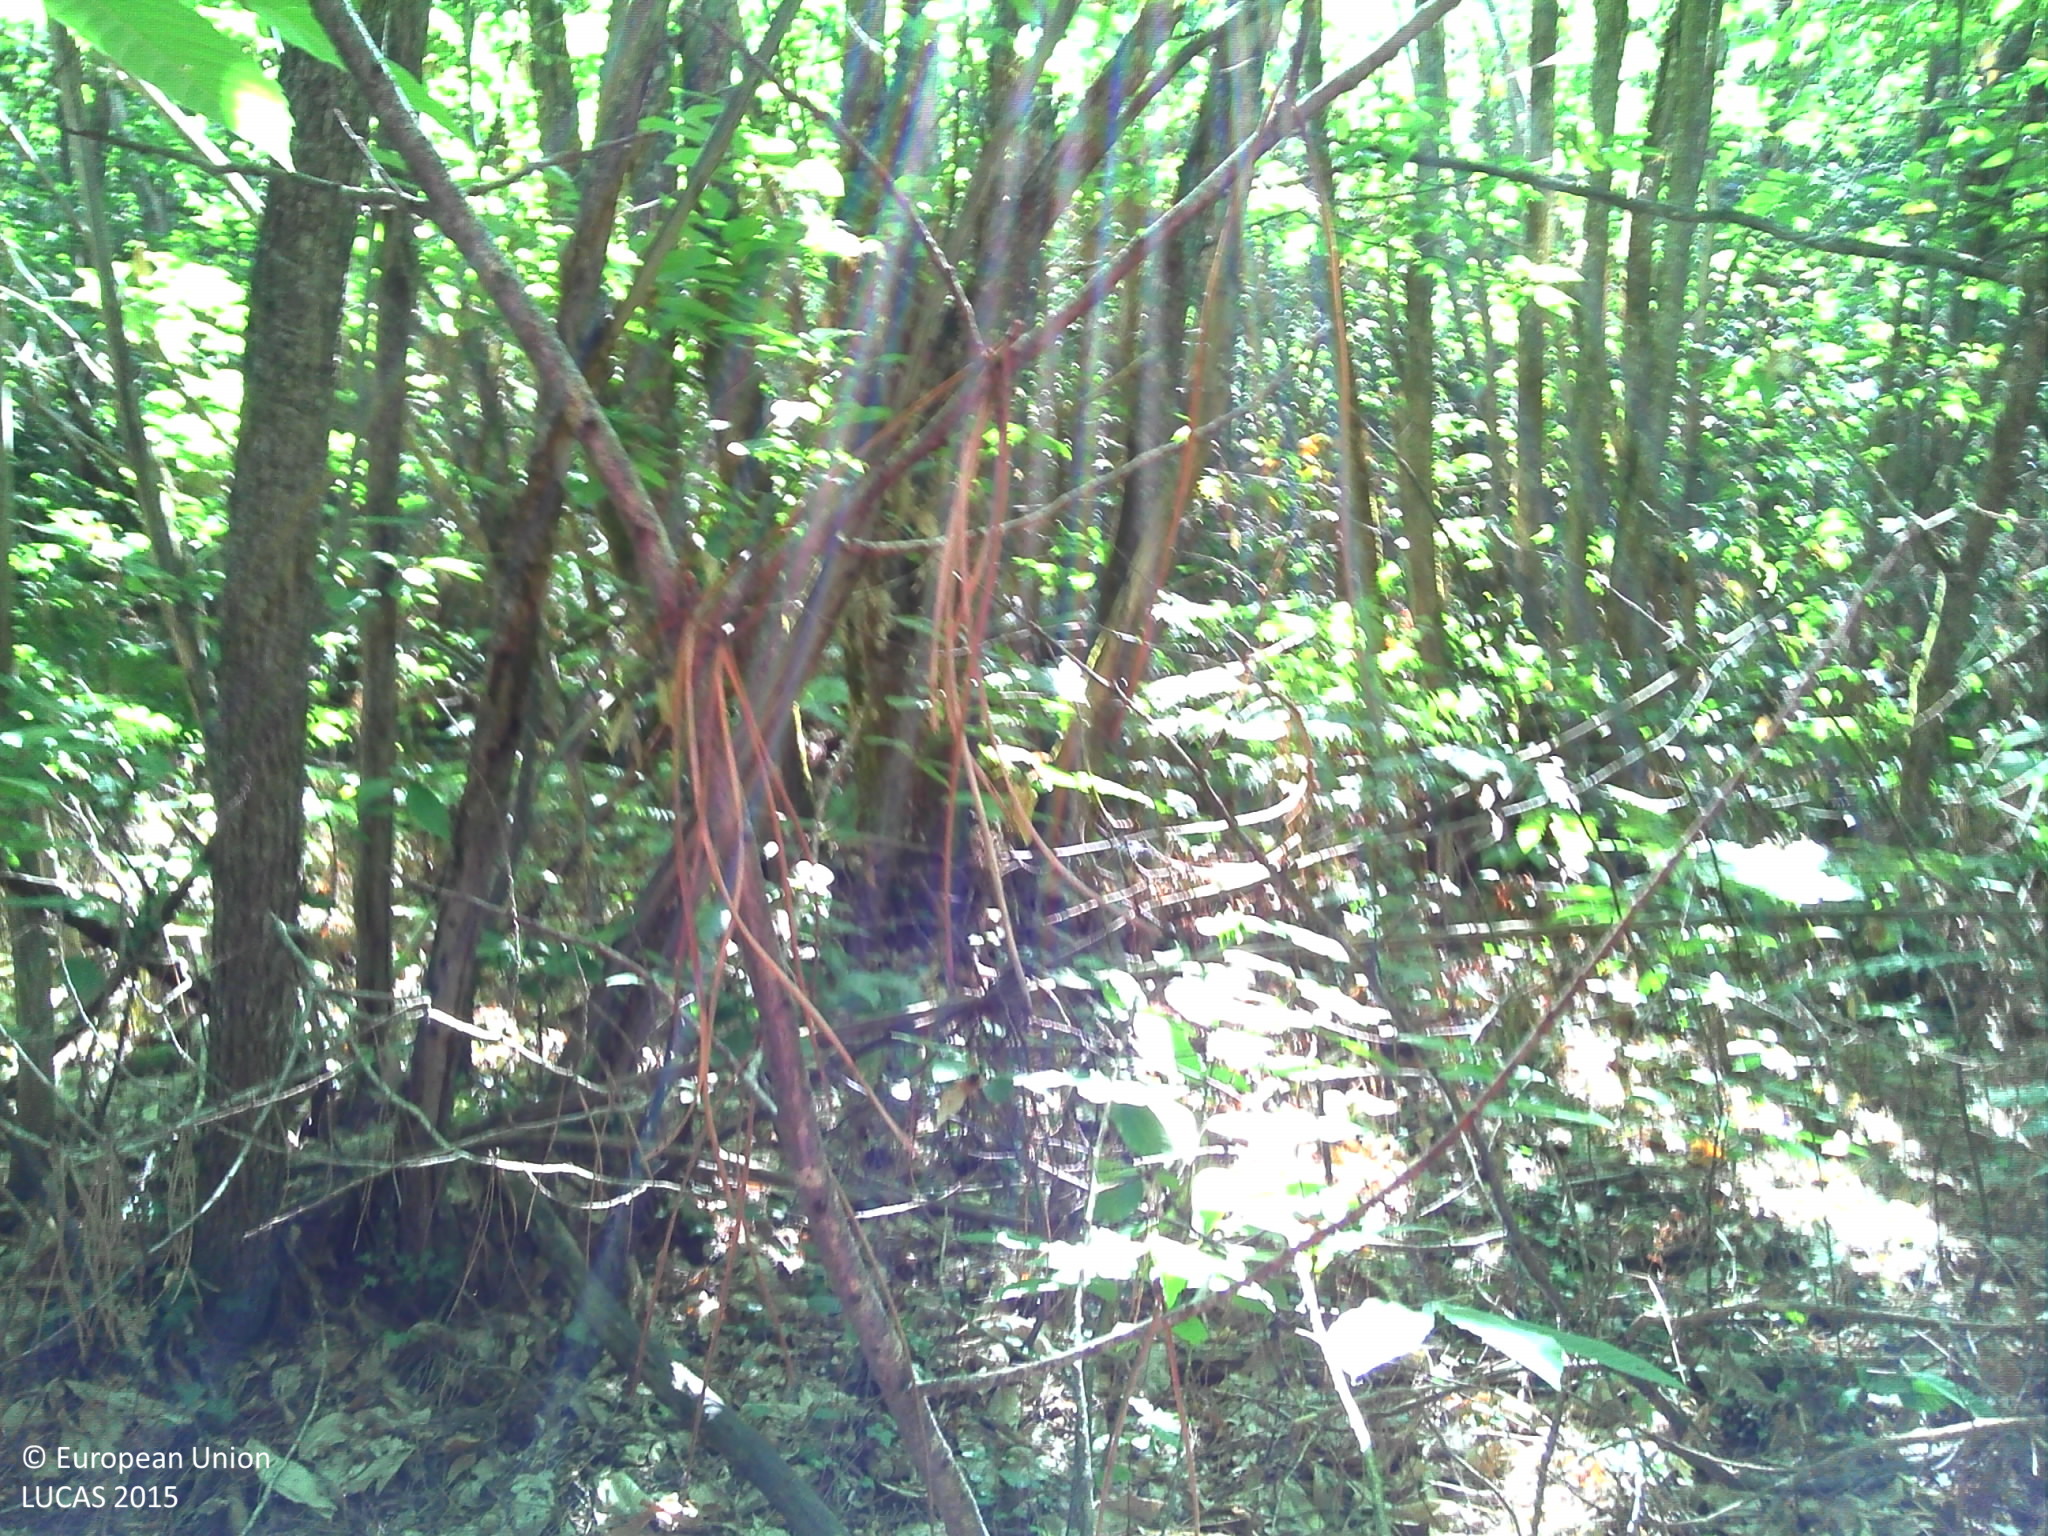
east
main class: Woodland
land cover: Broadleaved woodland
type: thermophilous deciduous forest
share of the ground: > 75 %
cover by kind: broadleaved forest trees 90 %, herbaceous plants 5 %, lichens and mosses 5 %
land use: Forestry
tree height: > 5 m
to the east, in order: Broadleaved woodland; Ditches and canals; Broadleaved woodland
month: July
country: FR
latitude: 44.9368
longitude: 0.5751
